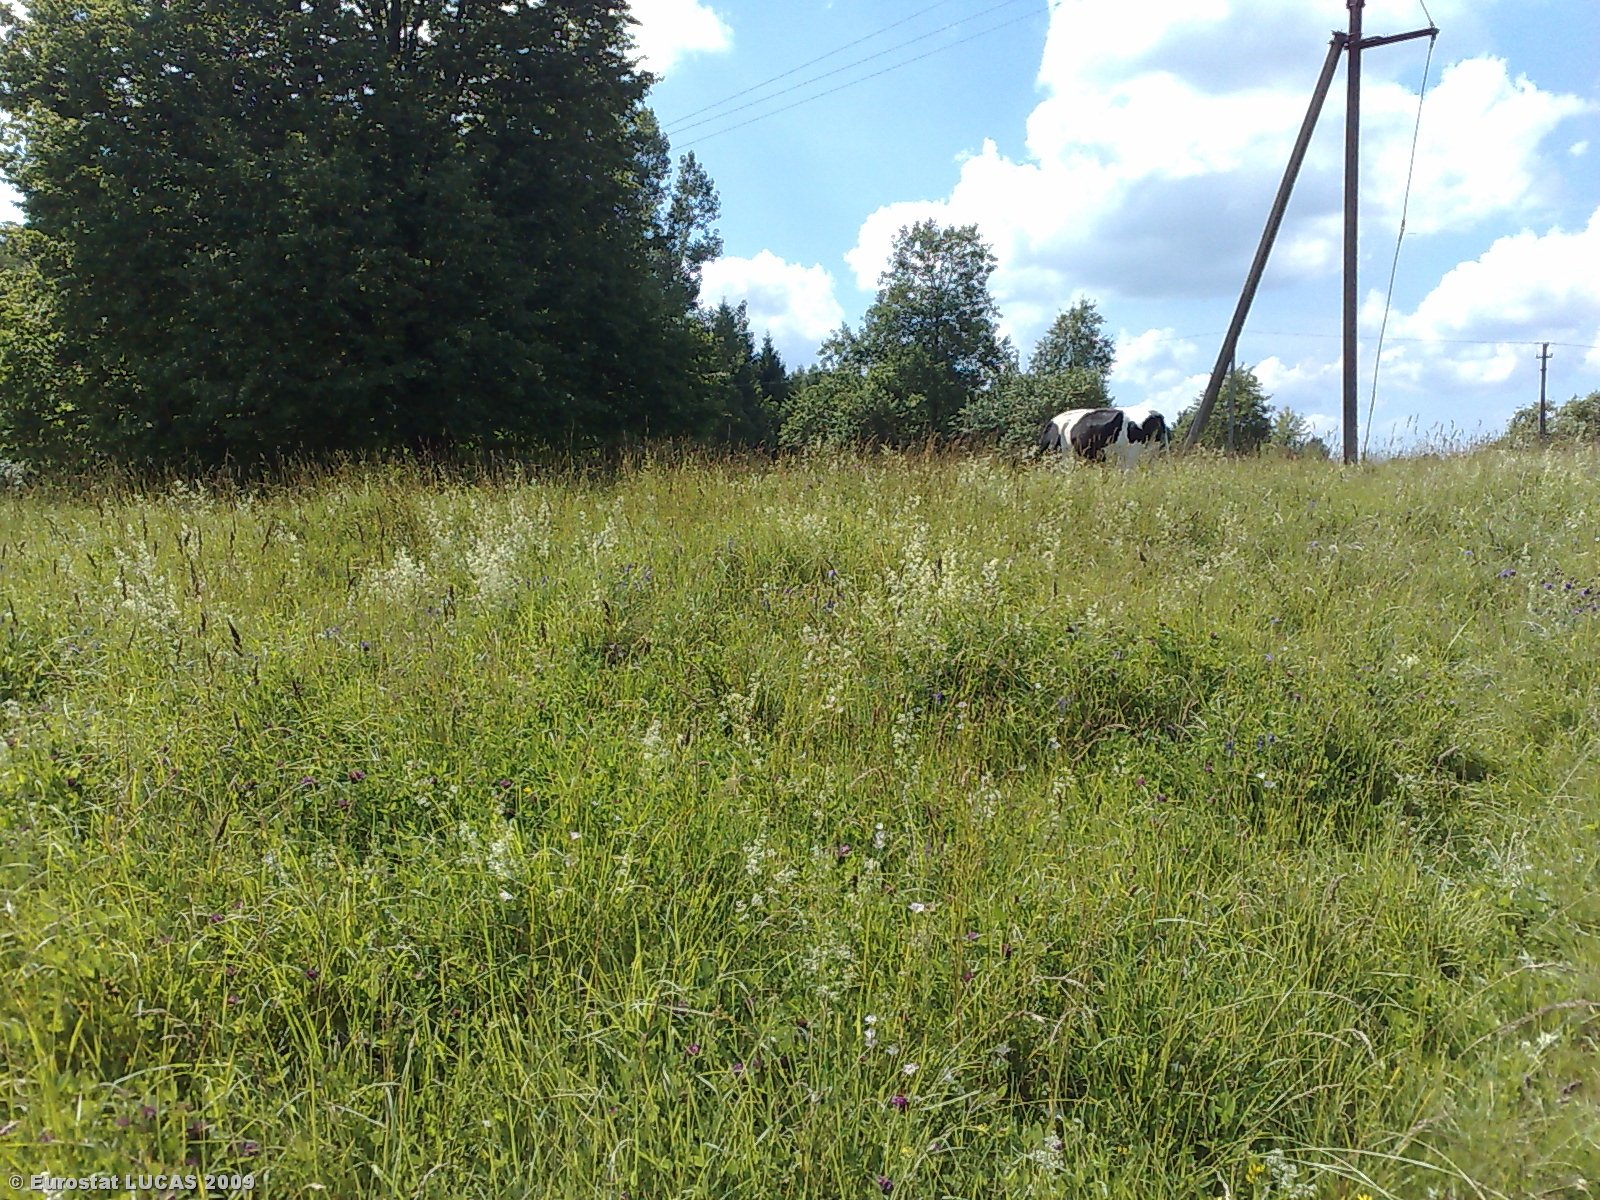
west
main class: Grassland
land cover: Grassland without tree/shrub cover
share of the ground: > 75 %
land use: Agriculture (excluding fallow land and kitchen gardens)
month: July
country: LT
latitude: 55.5681
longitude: 22.7354
